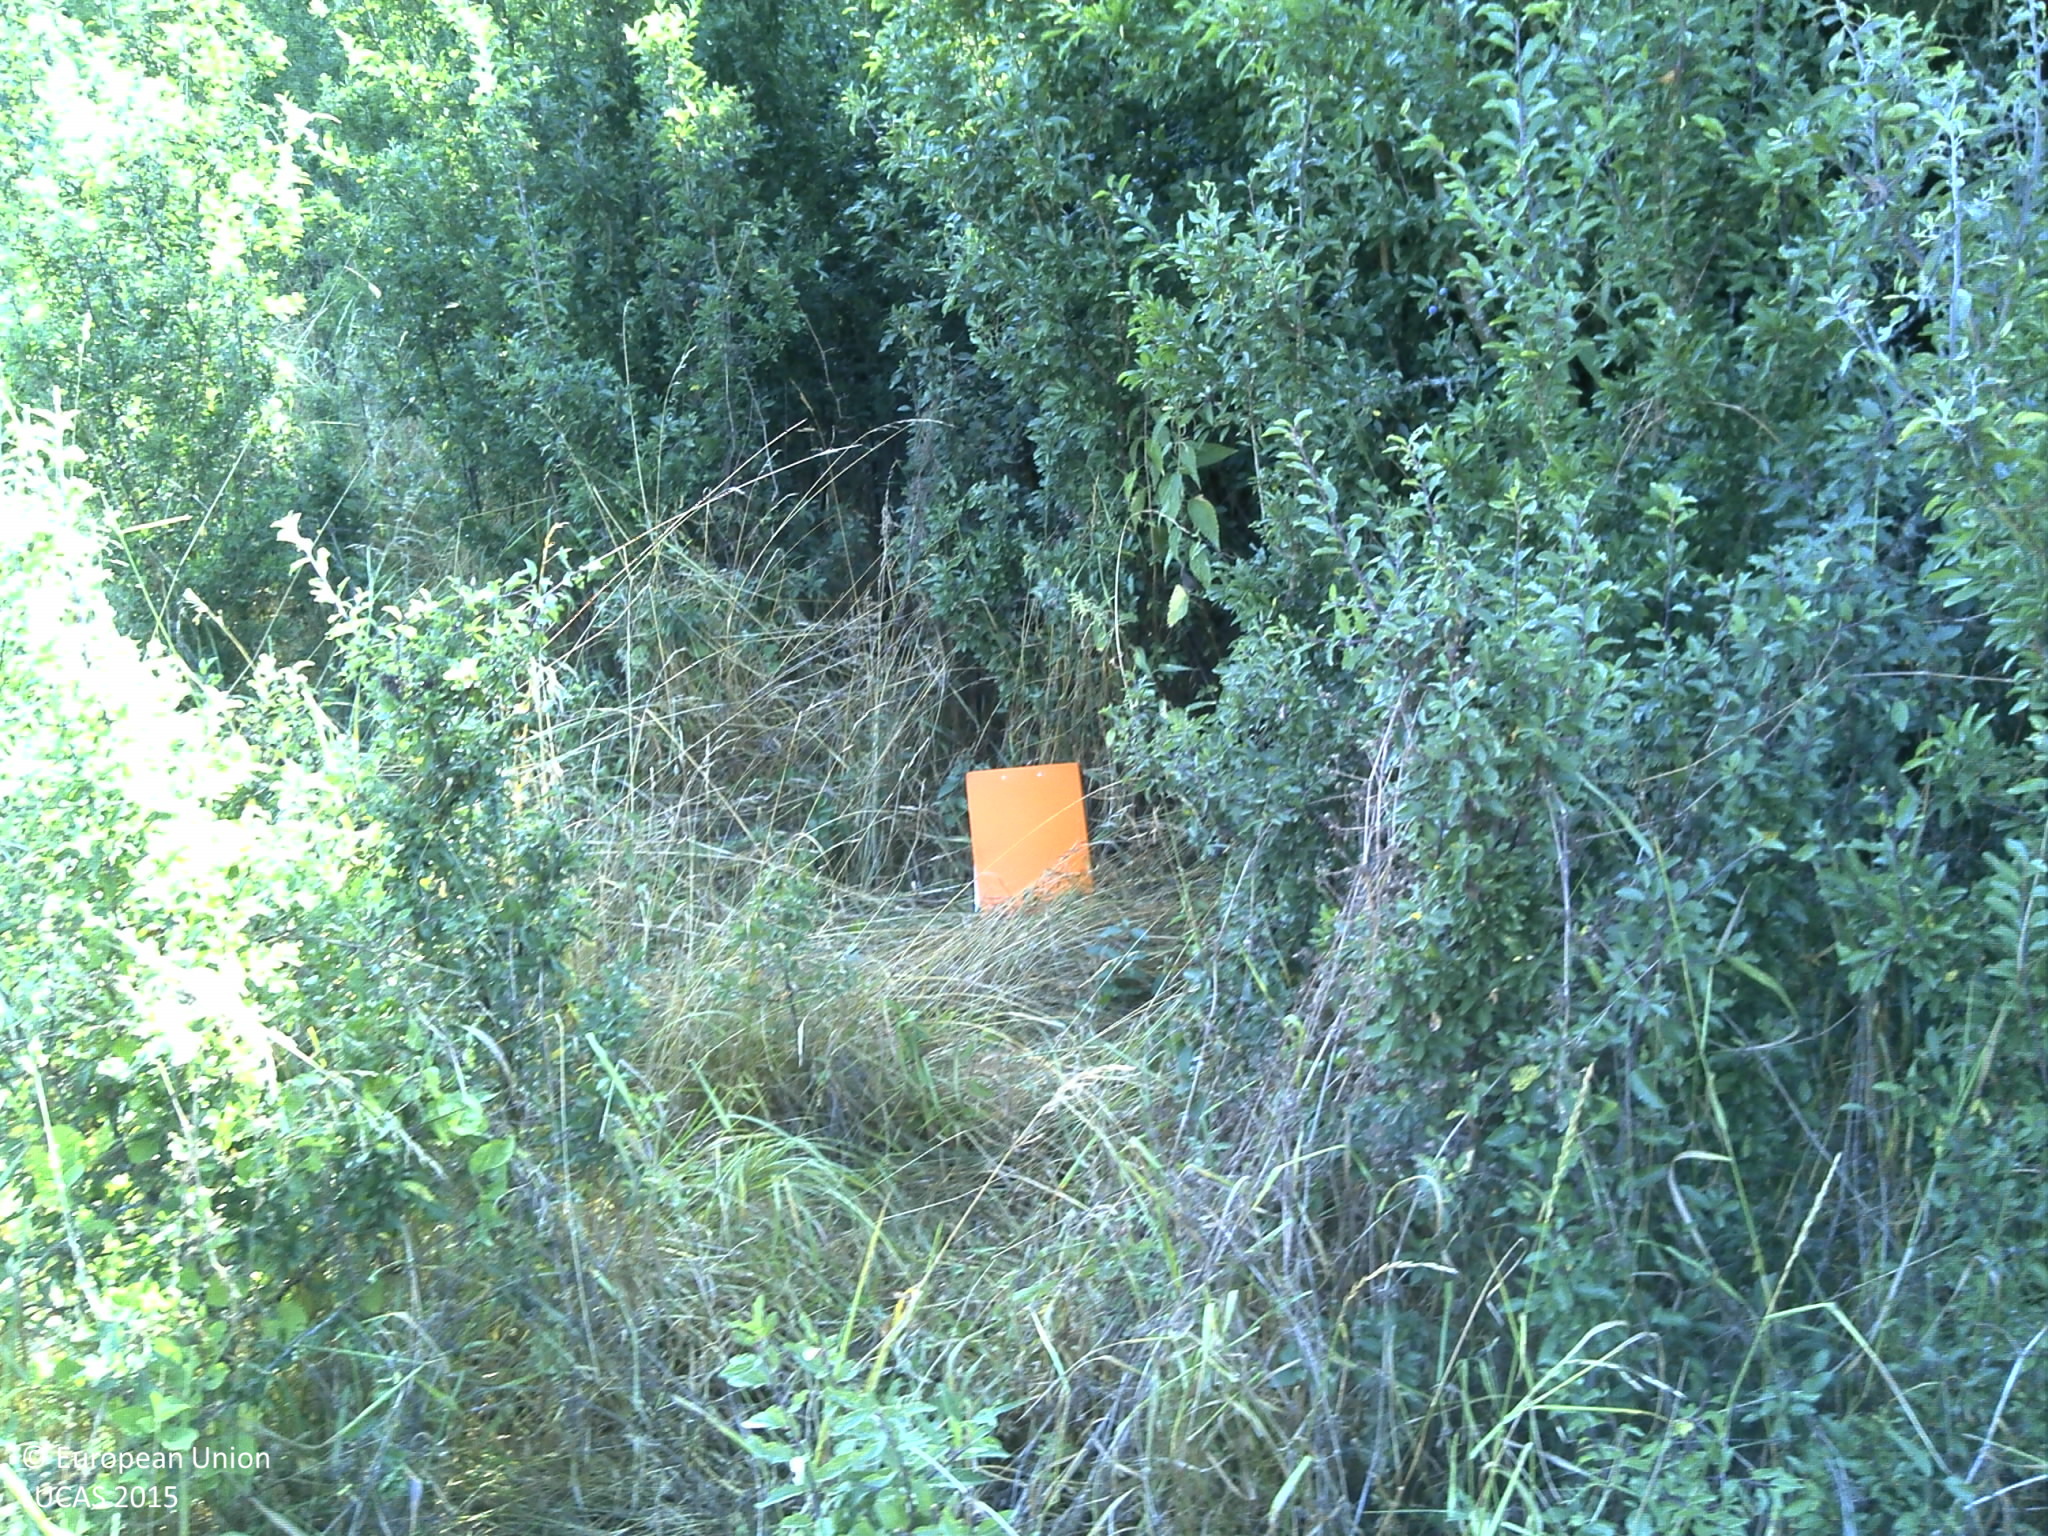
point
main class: Grassland
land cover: Spontaneously vegetated surfaces
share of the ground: > 75 %
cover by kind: herbaceous plants 100 %
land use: Agriculture (excluding fallow land and kitchen gardens)
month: July
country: FR
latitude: 48.3395
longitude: 6.2364
